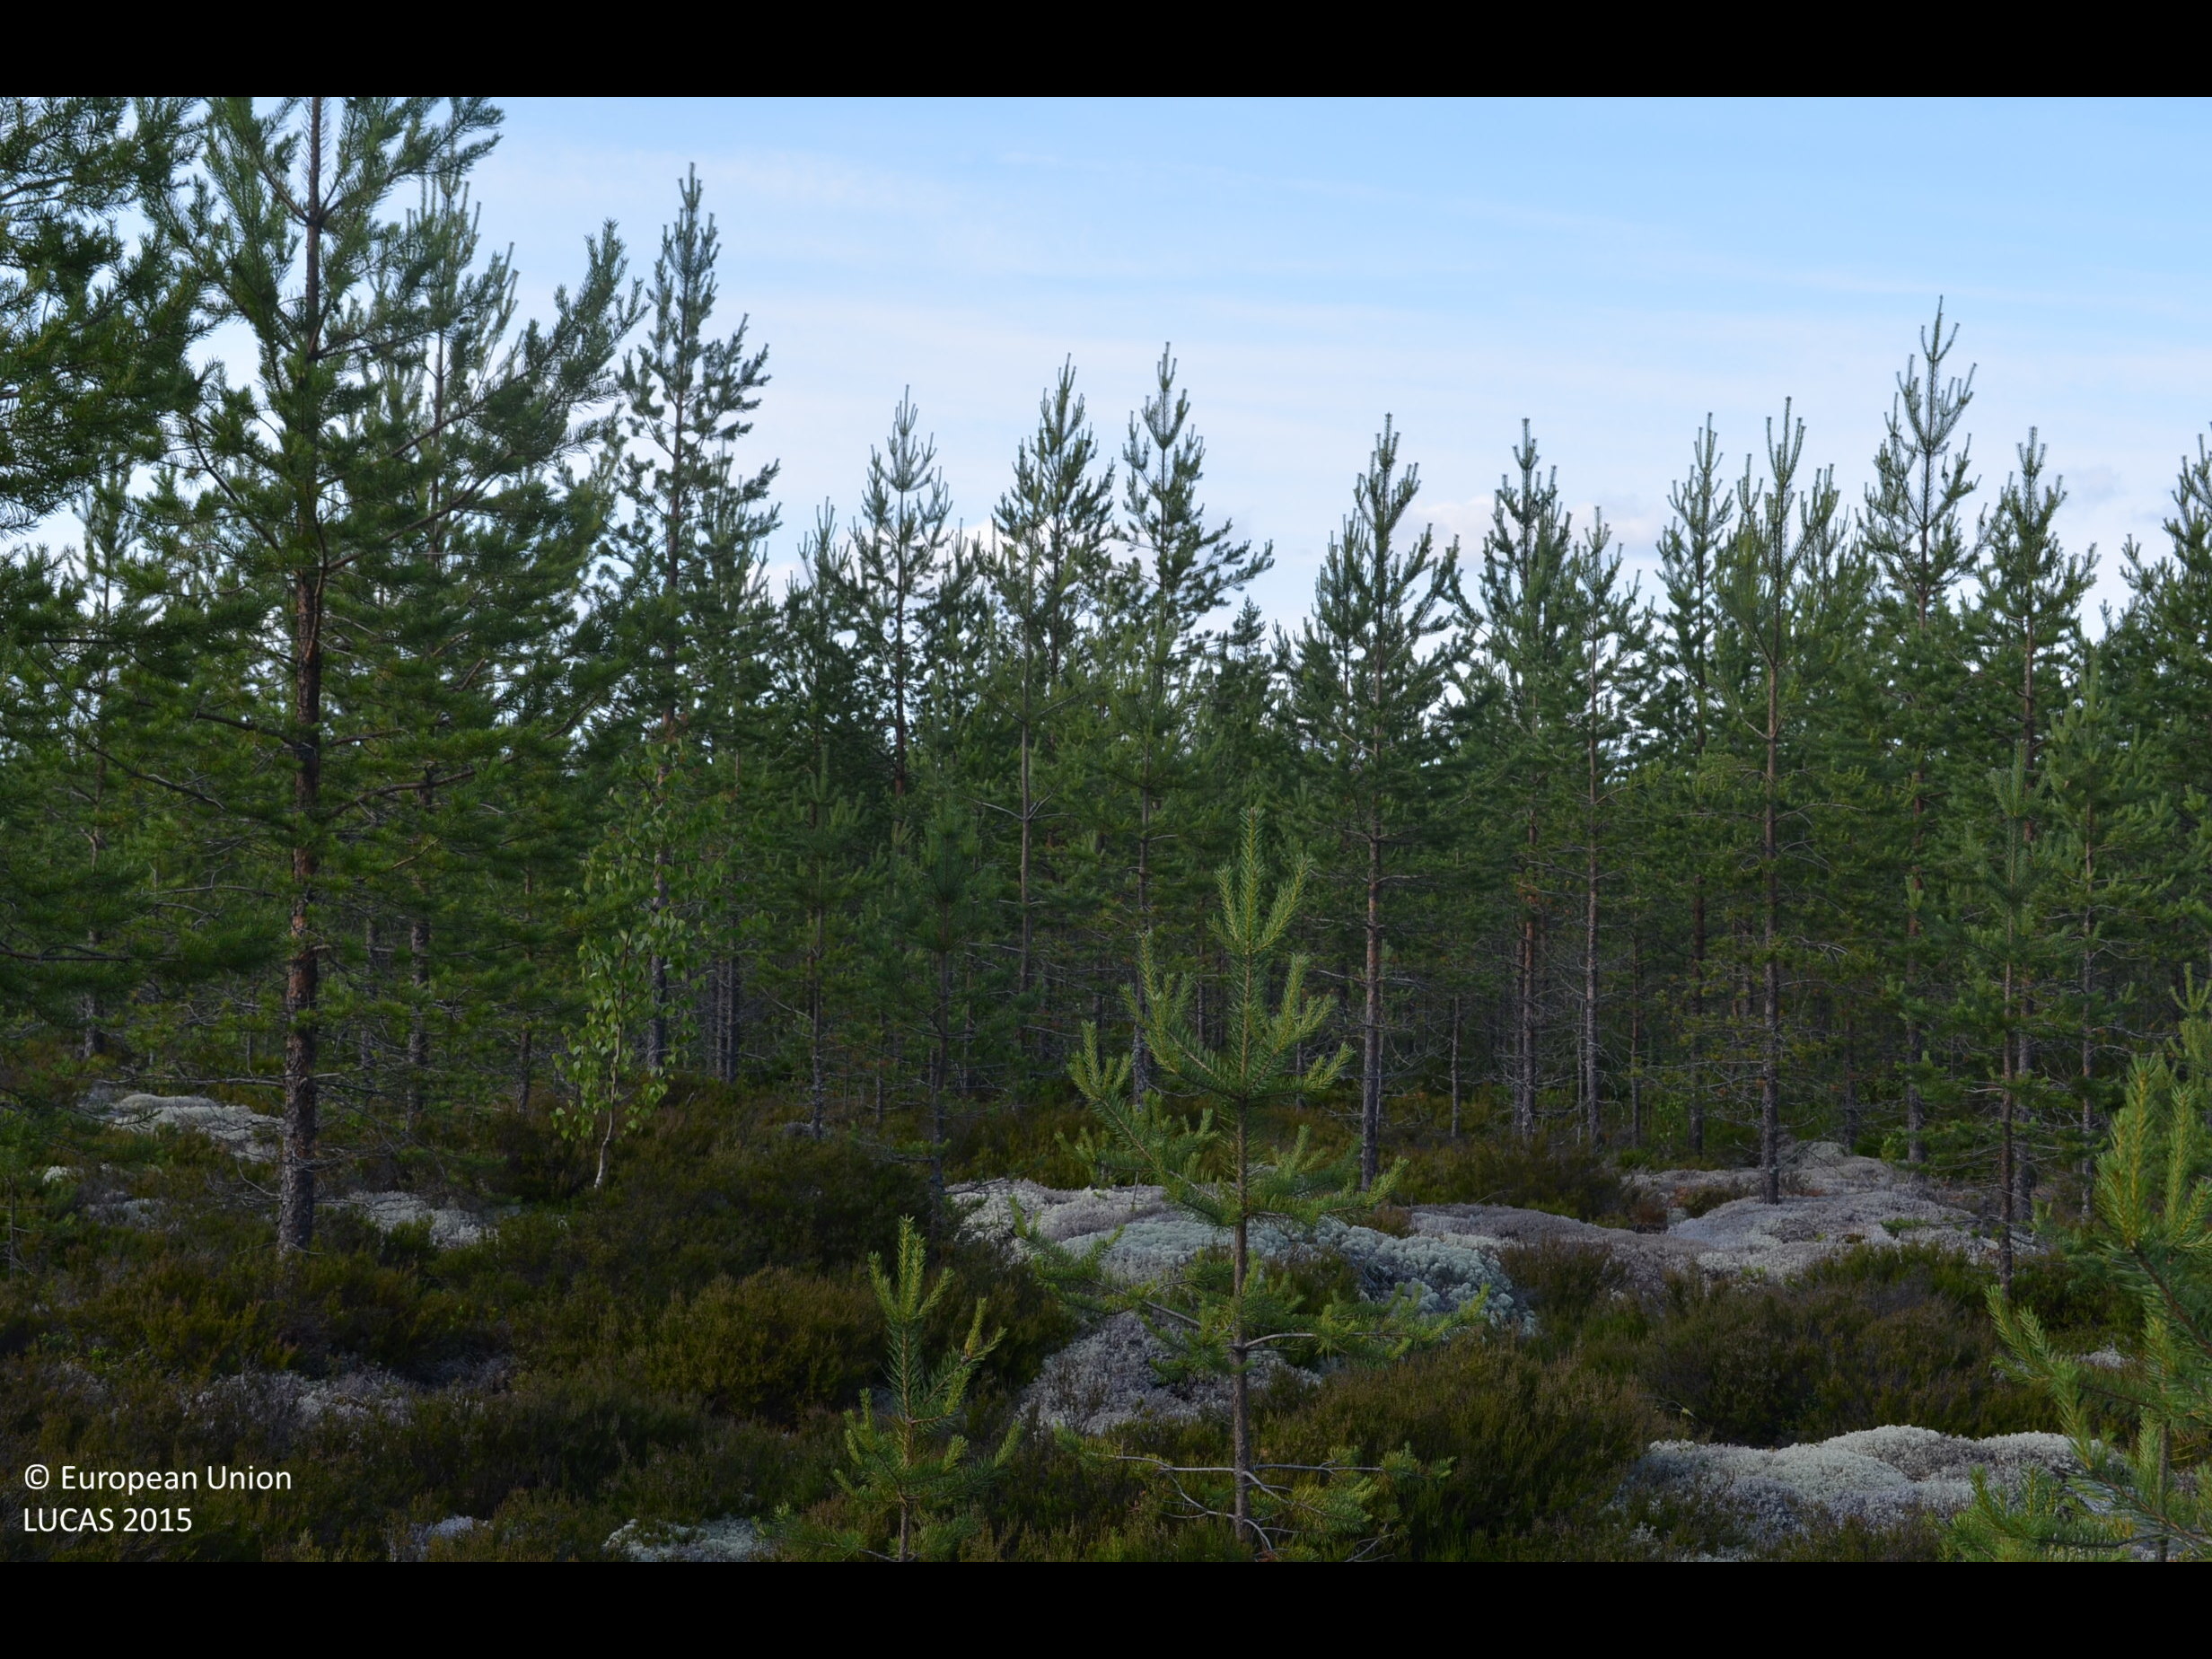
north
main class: Woodland
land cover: Pine dominated coniferous woodland
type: boreal forest
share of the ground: 50 - 75 %
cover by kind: coniferous forest trees 50 %, shrubs 35 %, lichens and mosses 15 %
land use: Forestry
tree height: < 5 m
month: July
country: FI
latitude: 62.3392
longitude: 23.6098
